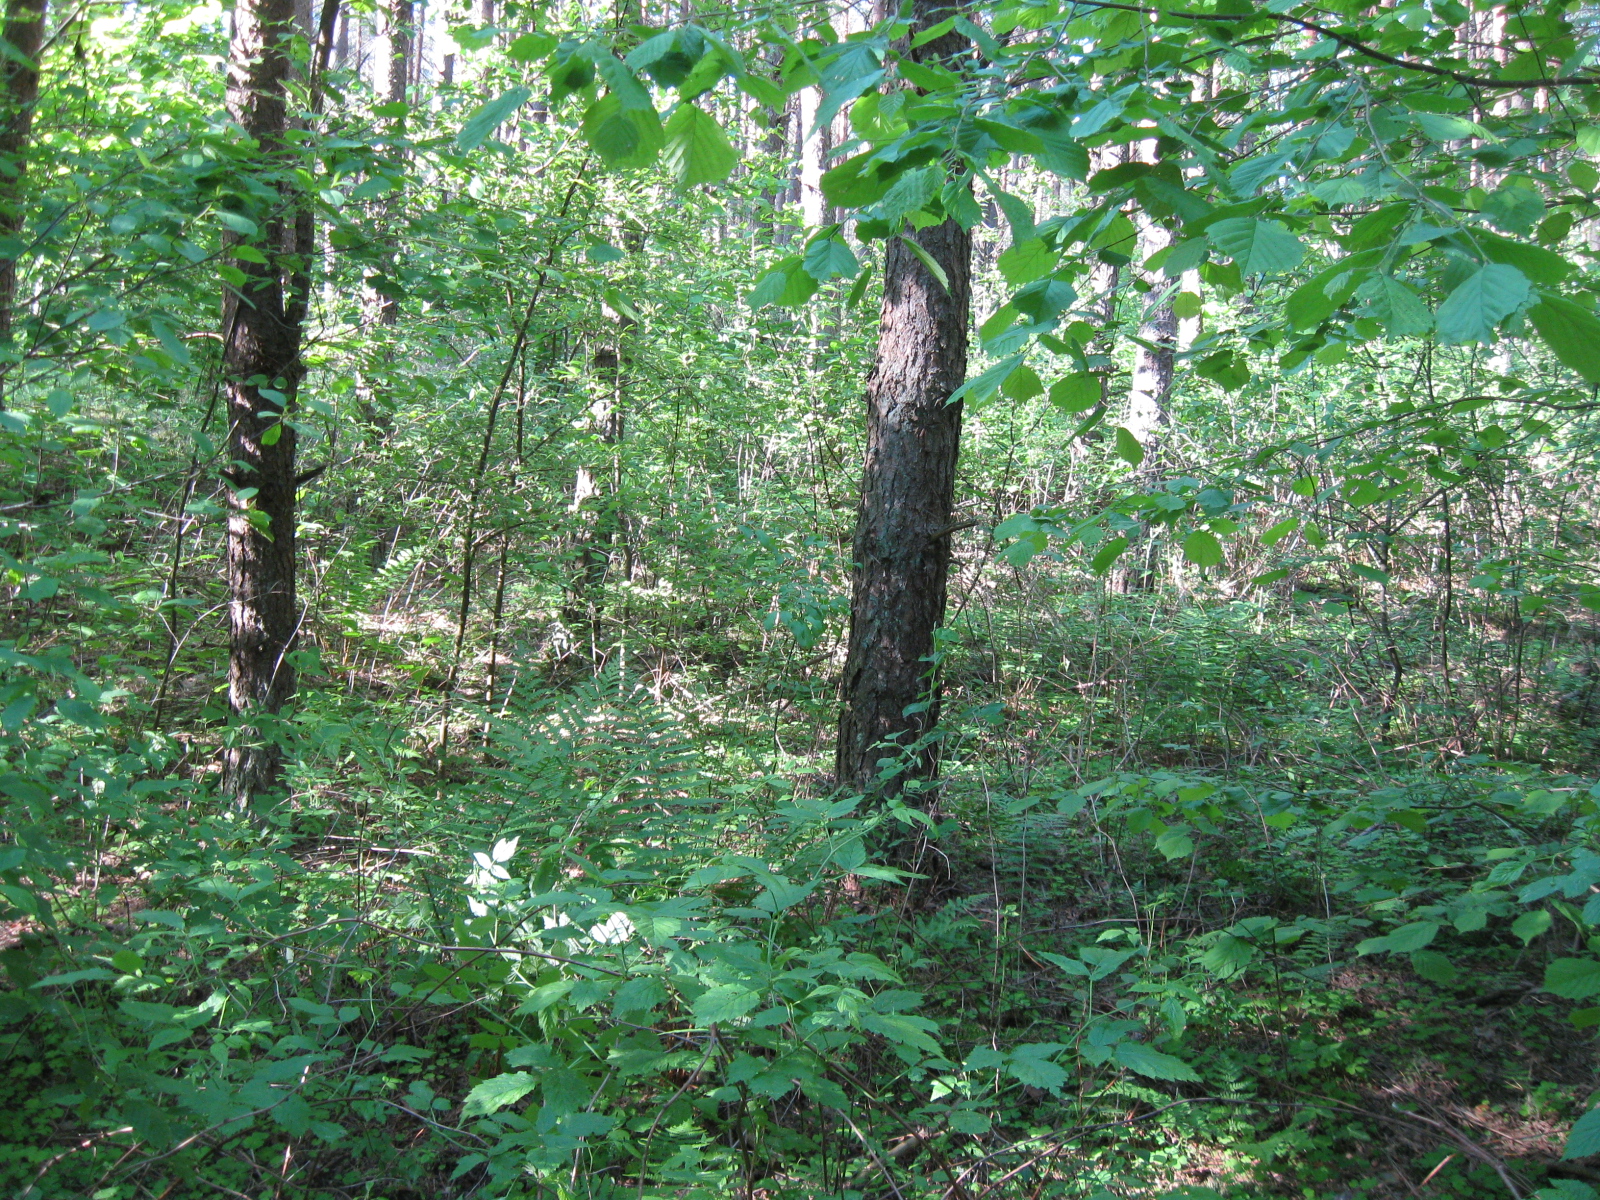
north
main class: Woodland
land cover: Pine dominated mixed woodland
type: hemiboreal forest and nemoral coniferous forest and mixed broadleaved-coniferous forest
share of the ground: > 75 %
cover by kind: coniferous forest trees 70 %, broadleaved forest trees 30 %
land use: Forestry
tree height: > 5 m
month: June
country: LT
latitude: 54.1166
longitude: 23.6867
